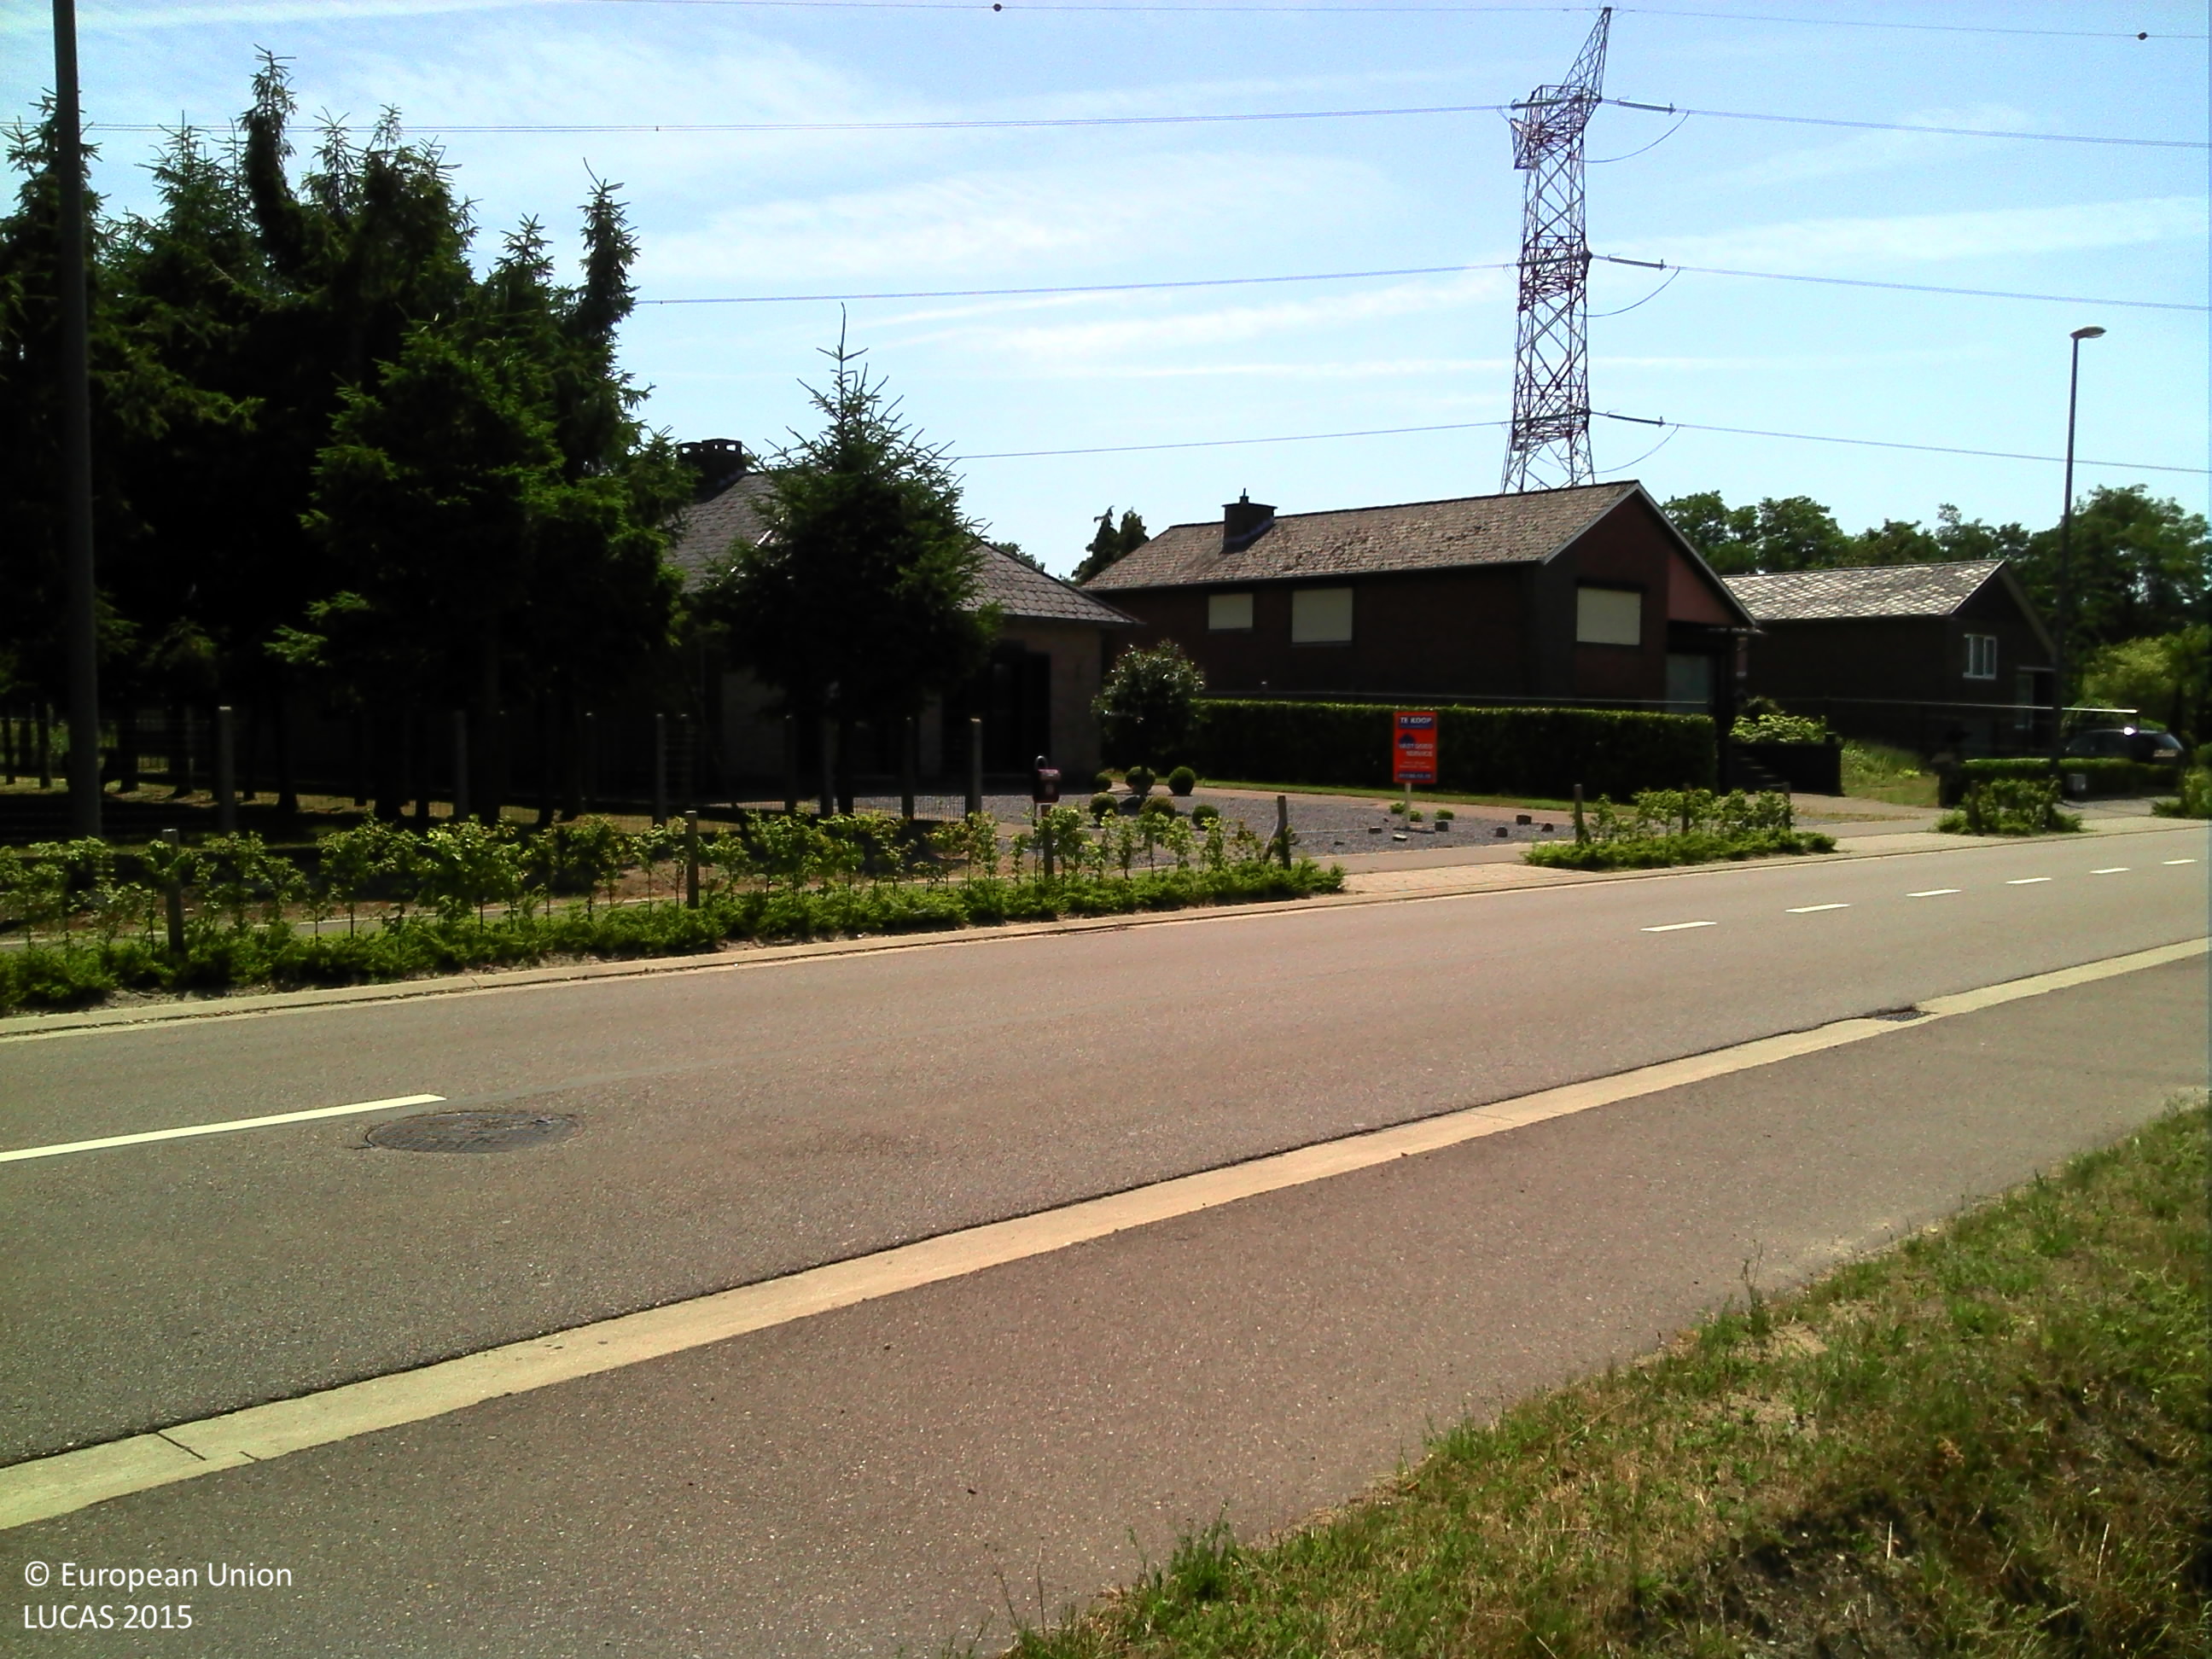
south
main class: Grassland
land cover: Grassland without tree/shrub cover
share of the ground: > 75 %
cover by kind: herbaceous plants 100 %
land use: Agriculture (excluding fallow land and kitchen gardens)
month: July
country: BE
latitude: 51.1387
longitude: 5.4674
